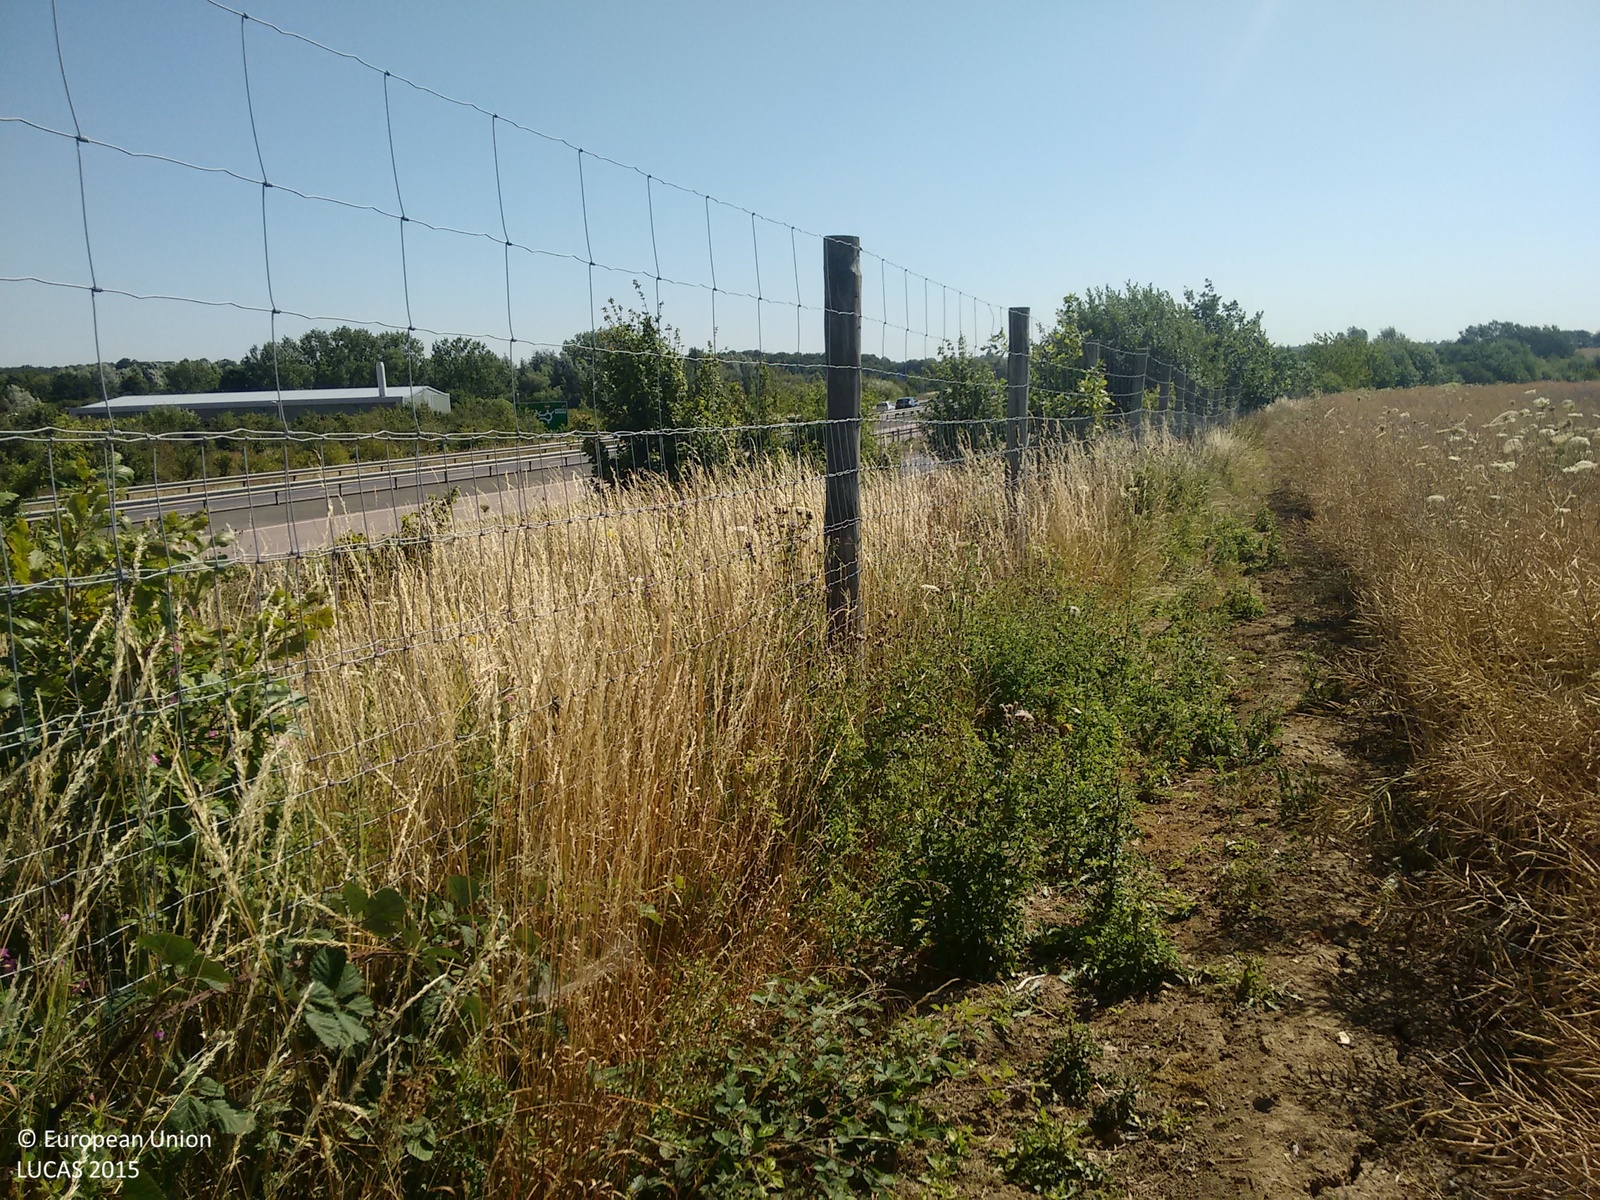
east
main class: Cropland
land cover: Rape and turnip rape
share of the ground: > 75 %
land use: Agriculture (excluding fallow land and kitchen gardens)
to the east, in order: Rape and turnip rape; Fences; Grass margins; Ditches and canals; Shrubland with sparse tree cover; Ditches and canals; Paved roads, cycling and walking lanes; Grass margins; Ditches and canals; Grassland without tree/shrub cover
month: July
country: GB
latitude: 51.8586
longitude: 0.3732
